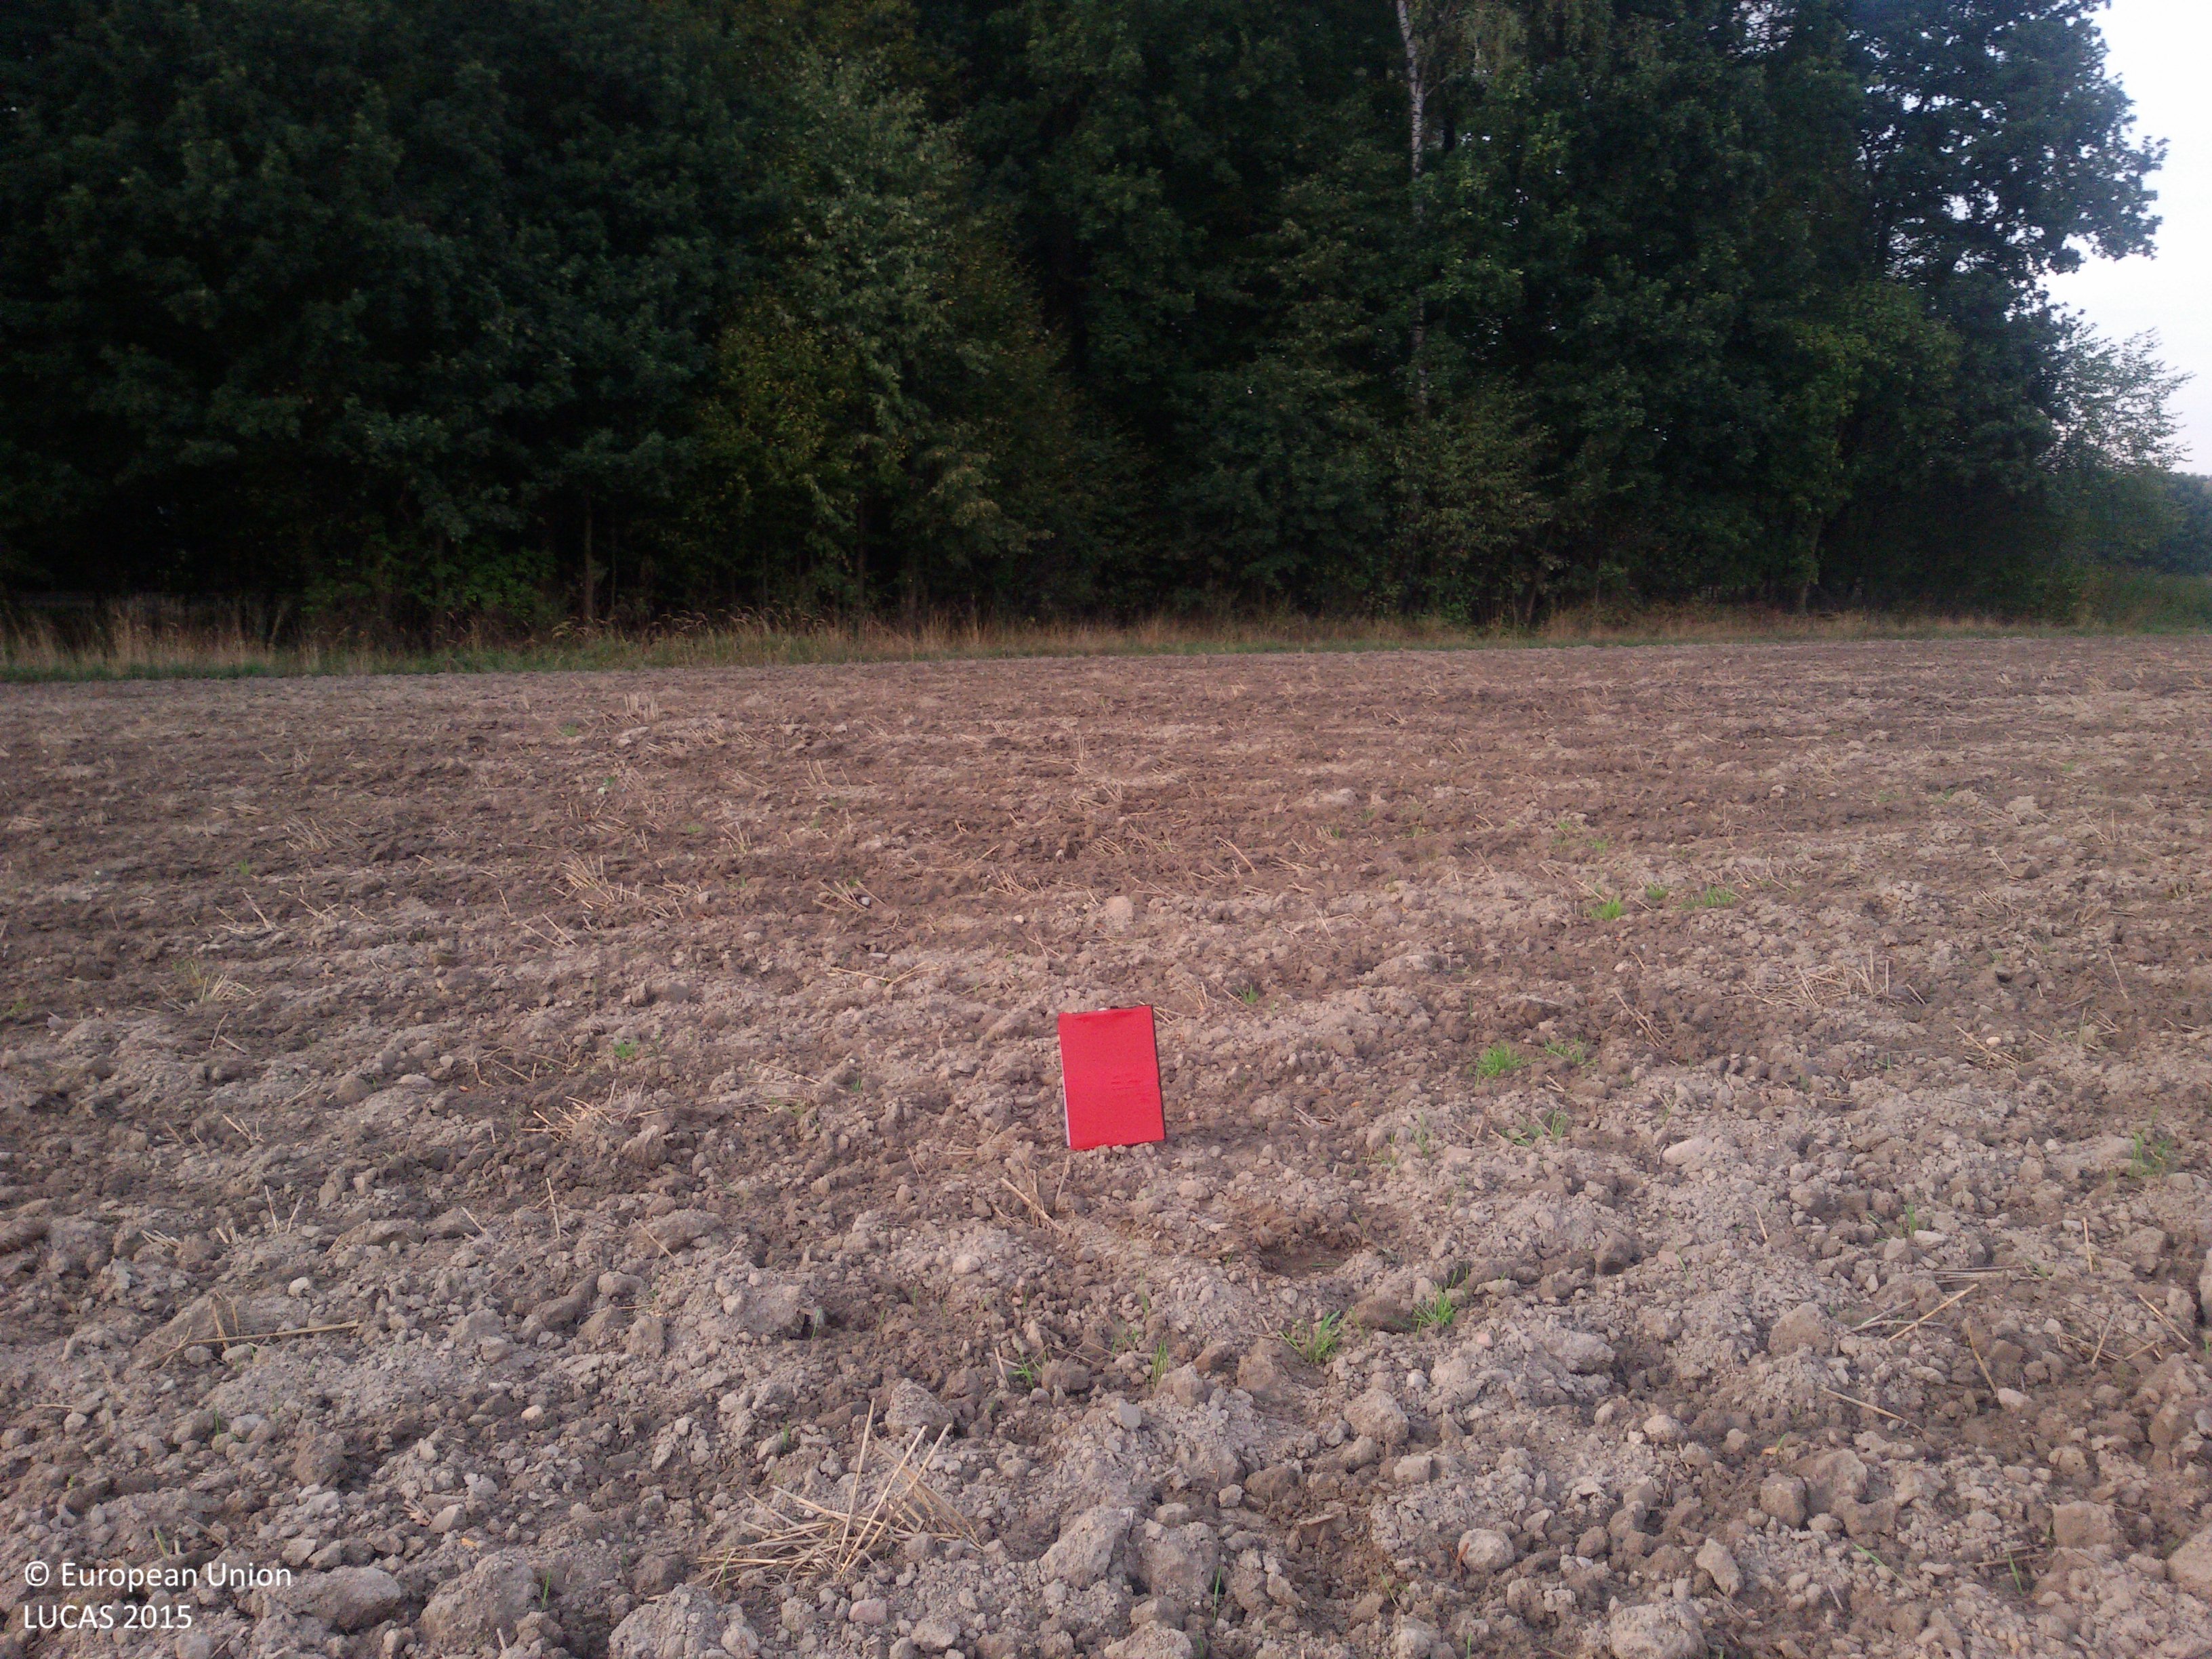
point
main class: Cropland
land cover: Triticale
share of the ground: < 10 %
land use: Agriculture (excluding fallow land and kitchen gardens)
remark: Harvested field
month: September
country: PL
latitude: 50.6813
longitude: 18.7249
